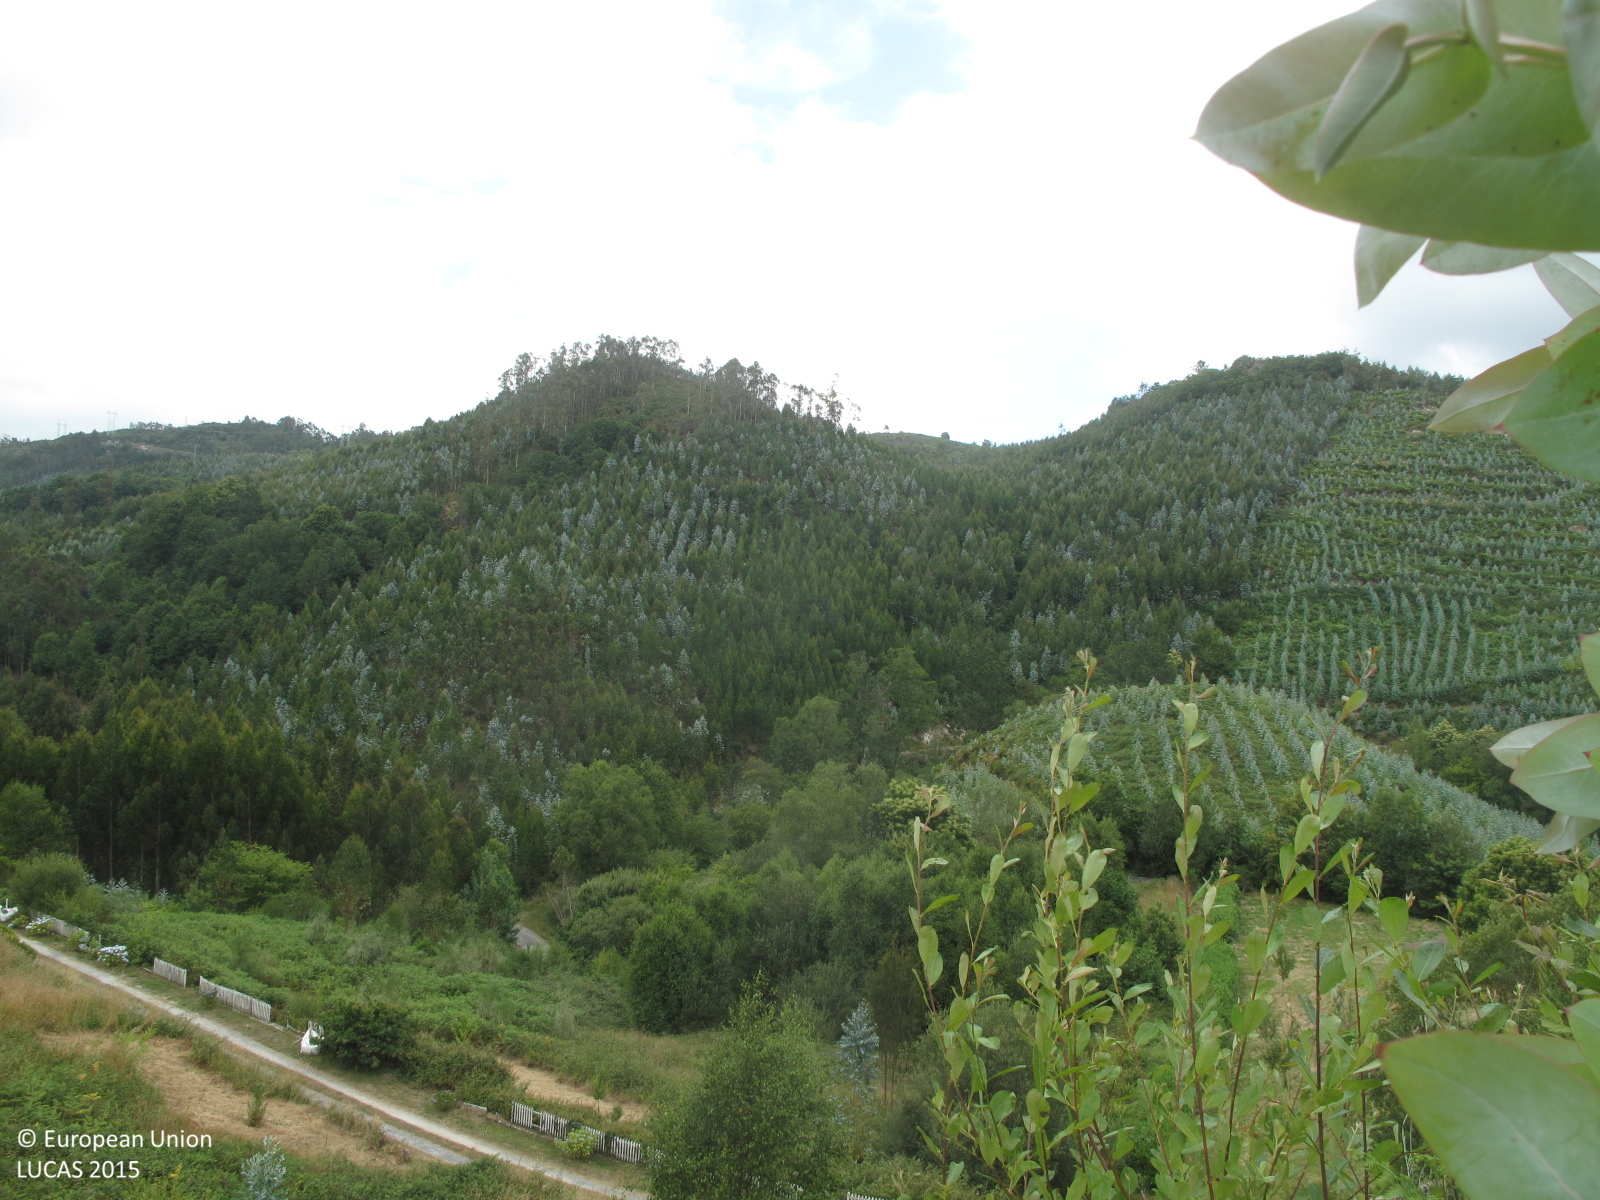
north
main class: Woodland
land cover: Broadleaved woodland
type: exotic forest
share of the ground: 10 - 25 %
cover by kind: herbaceous plants 70 %, broadleaved forest trees 20 %, shrubs 10 %
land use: Forestry
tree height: < 5 m
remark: Clear cut
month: July
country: ES
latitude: 43.4824
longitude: -7.9860
